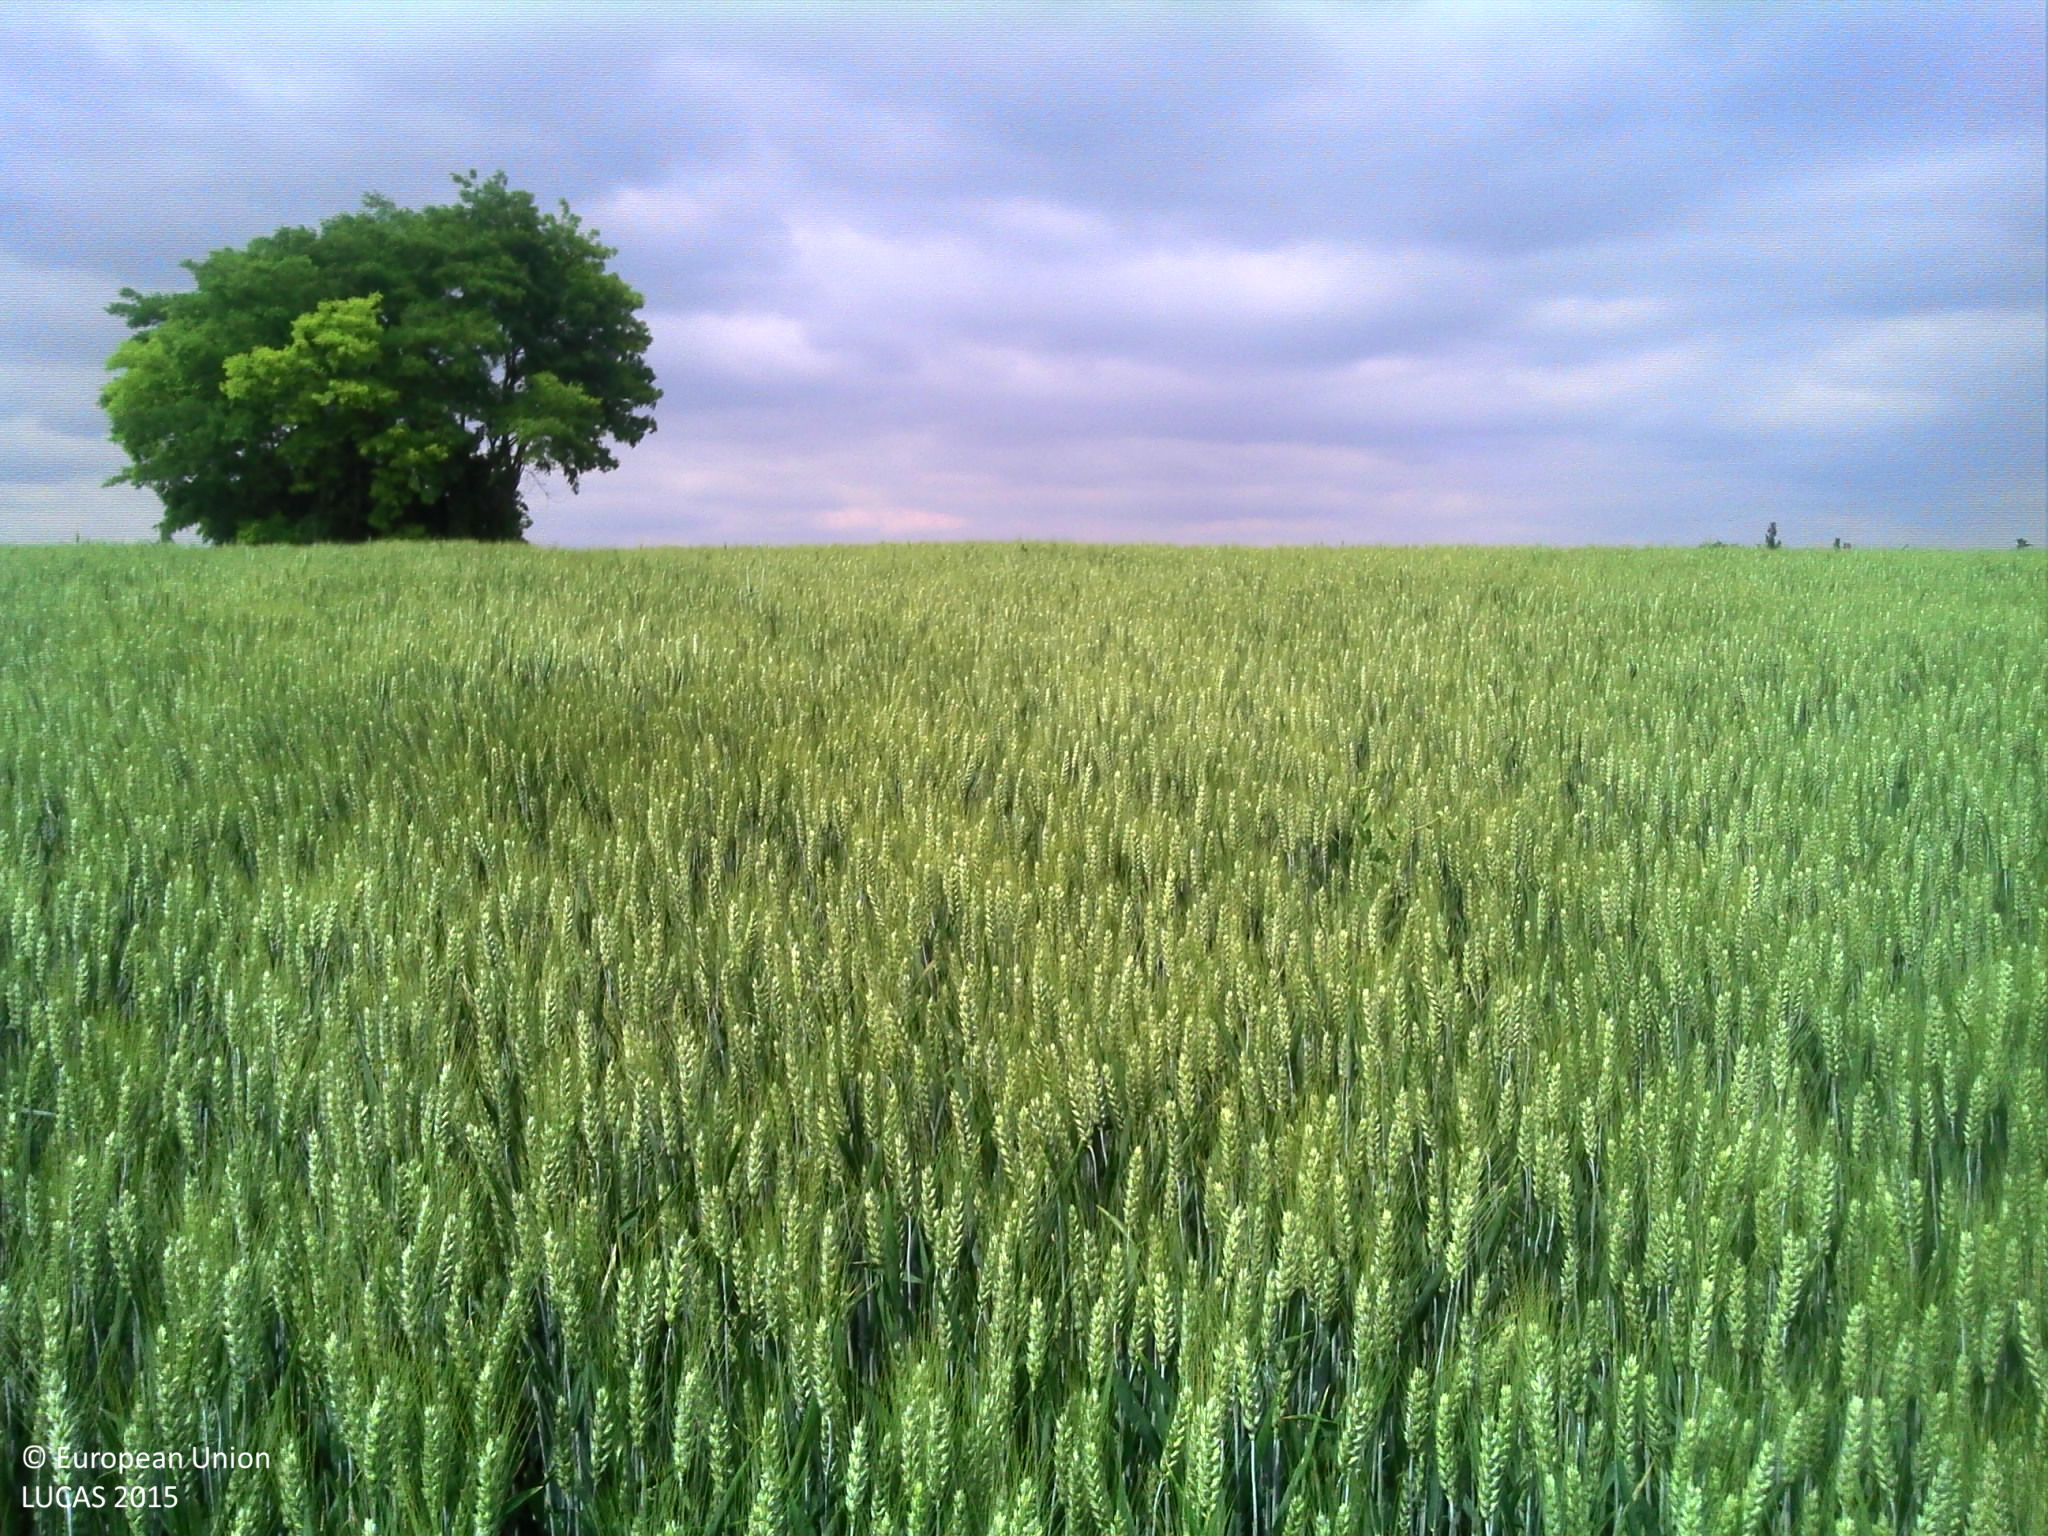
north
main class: Cropland
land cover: Common wheat
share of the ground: > 75 %
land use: Agriculture (excluding fallow land and kitchen gardens)
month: June
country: FR
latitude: 48.5575
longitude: 7.6026
